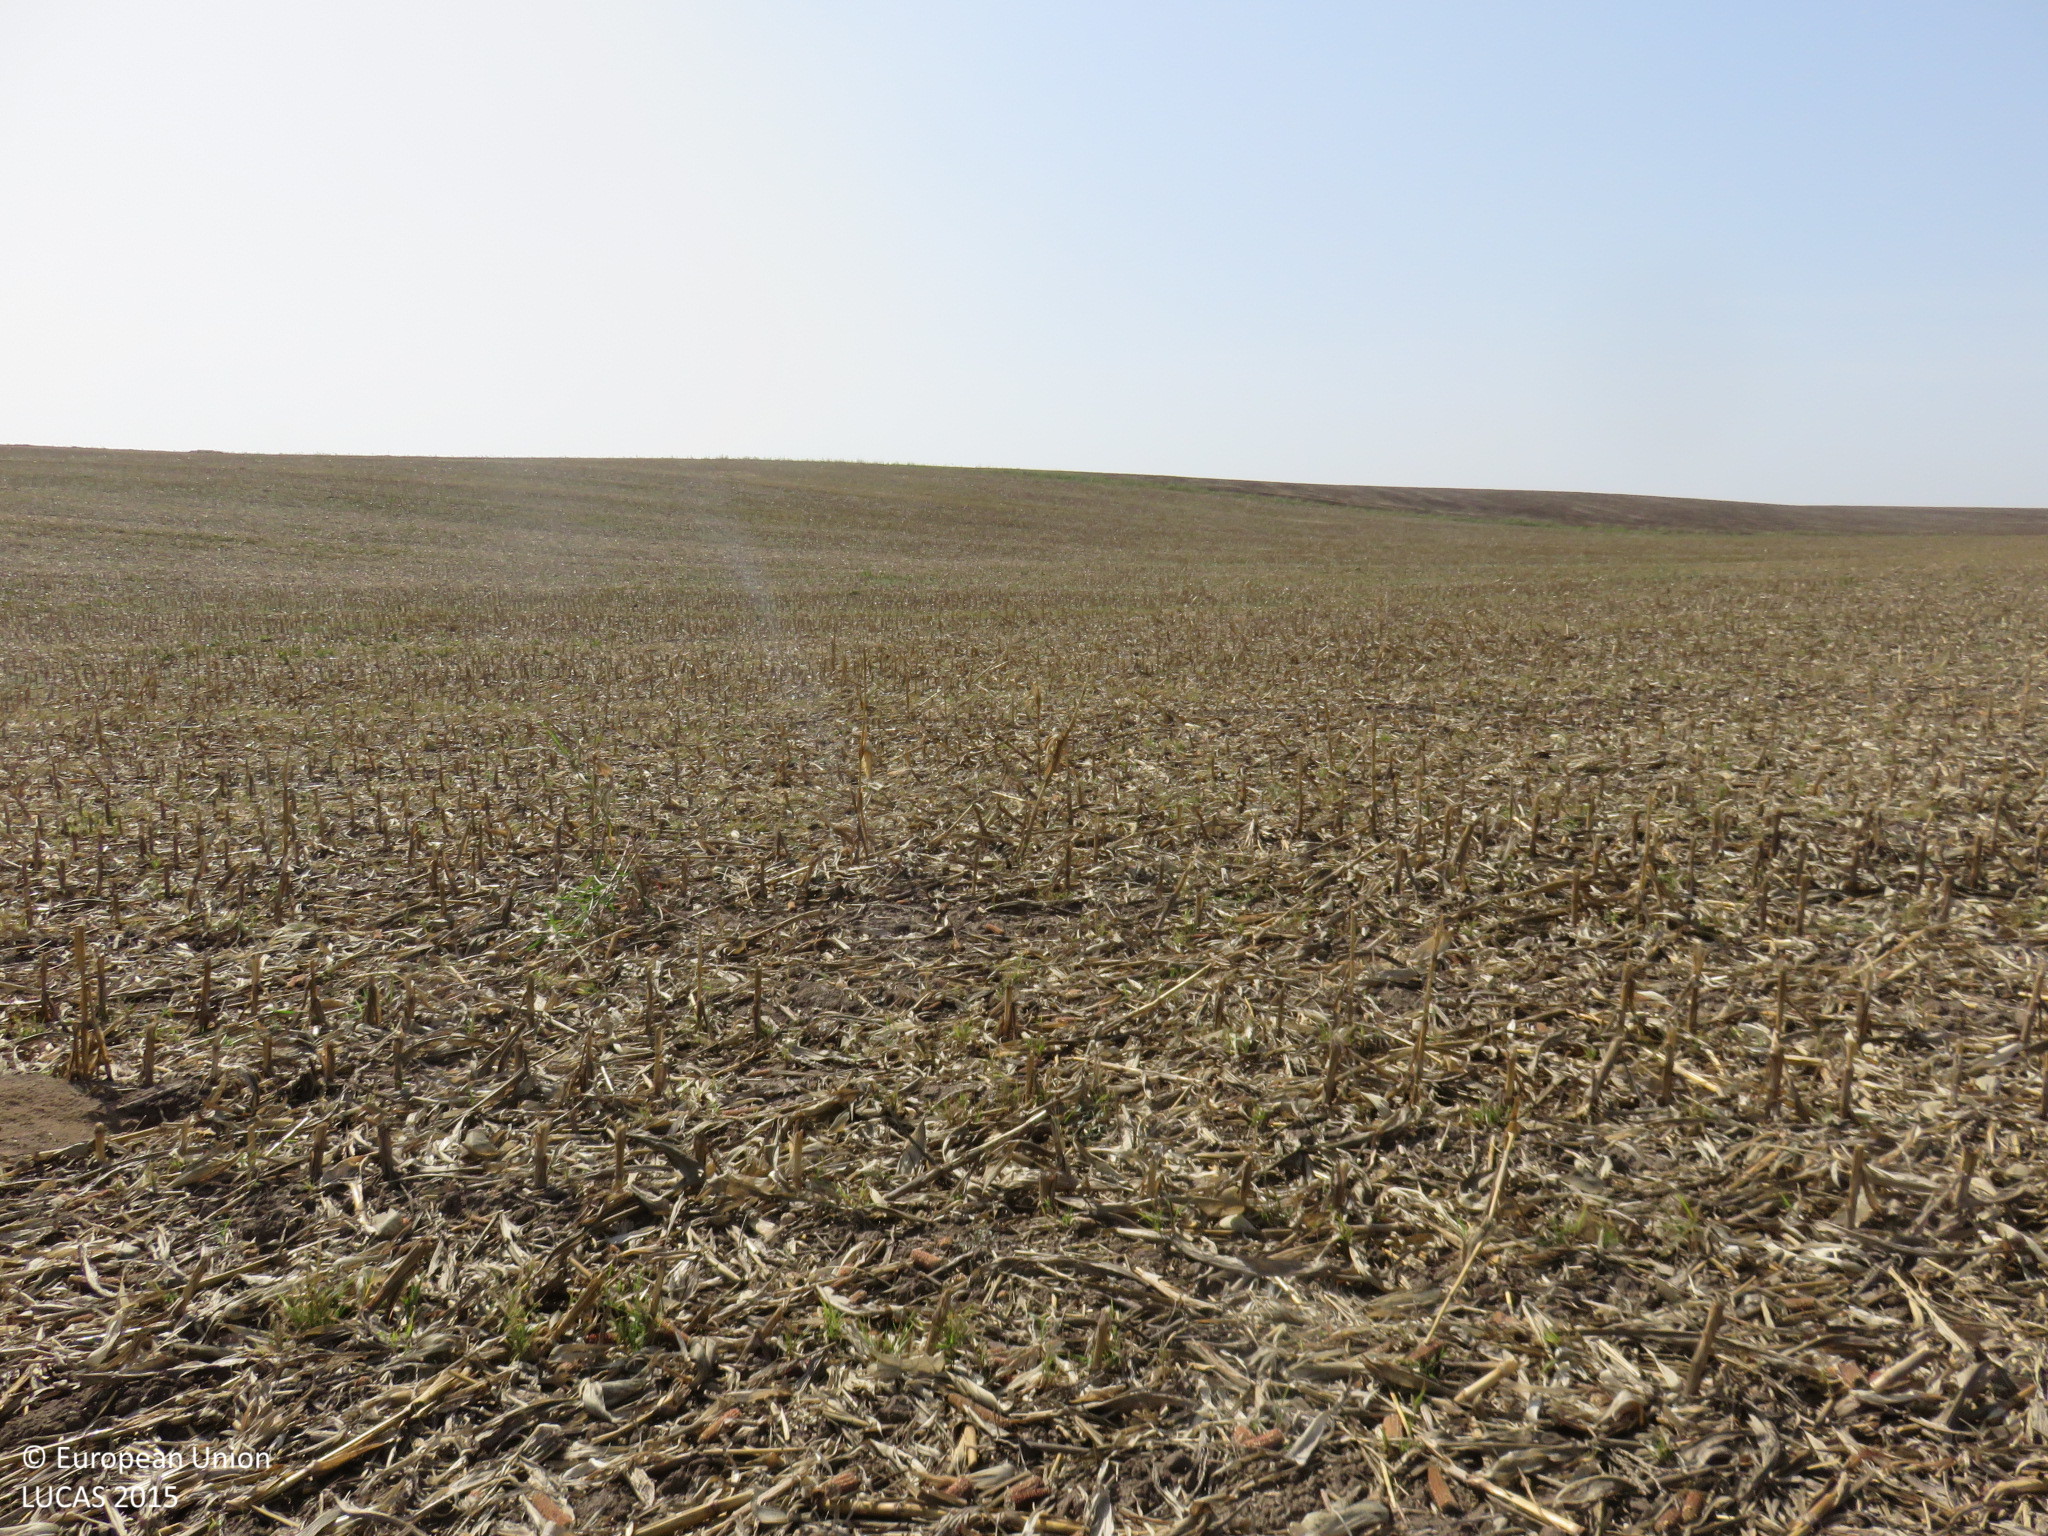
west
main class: Cropland
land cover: Maize
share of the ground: > 75 %
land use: Agriculture (excluding fallow land and kitchen gardens)
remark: Harvested field
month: September
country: BG
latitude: 43.5730
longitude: 24.5633
